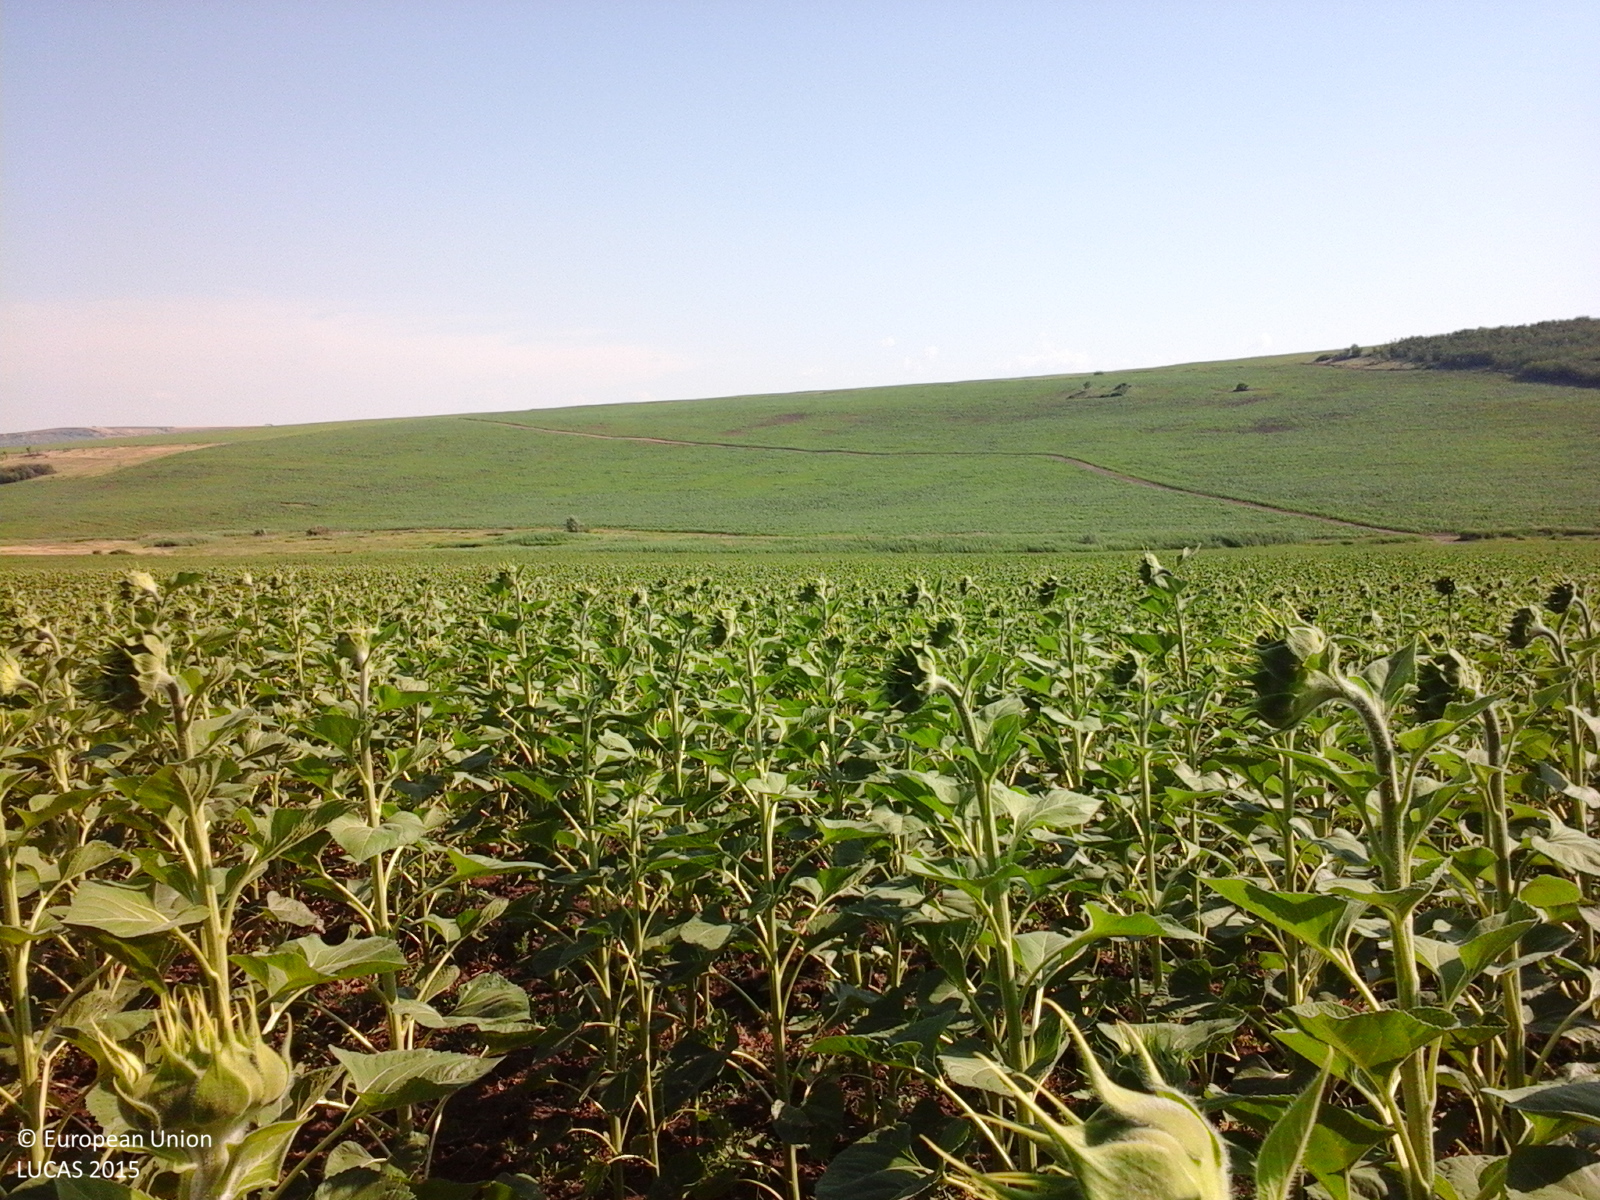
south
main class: Cropland
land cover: Sunflower
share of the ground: 50 - 75 %
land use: Agriculture (excluding fallow land and kitchen gardens)
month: June
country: RO
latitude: 46.8837
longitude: 28.0435
